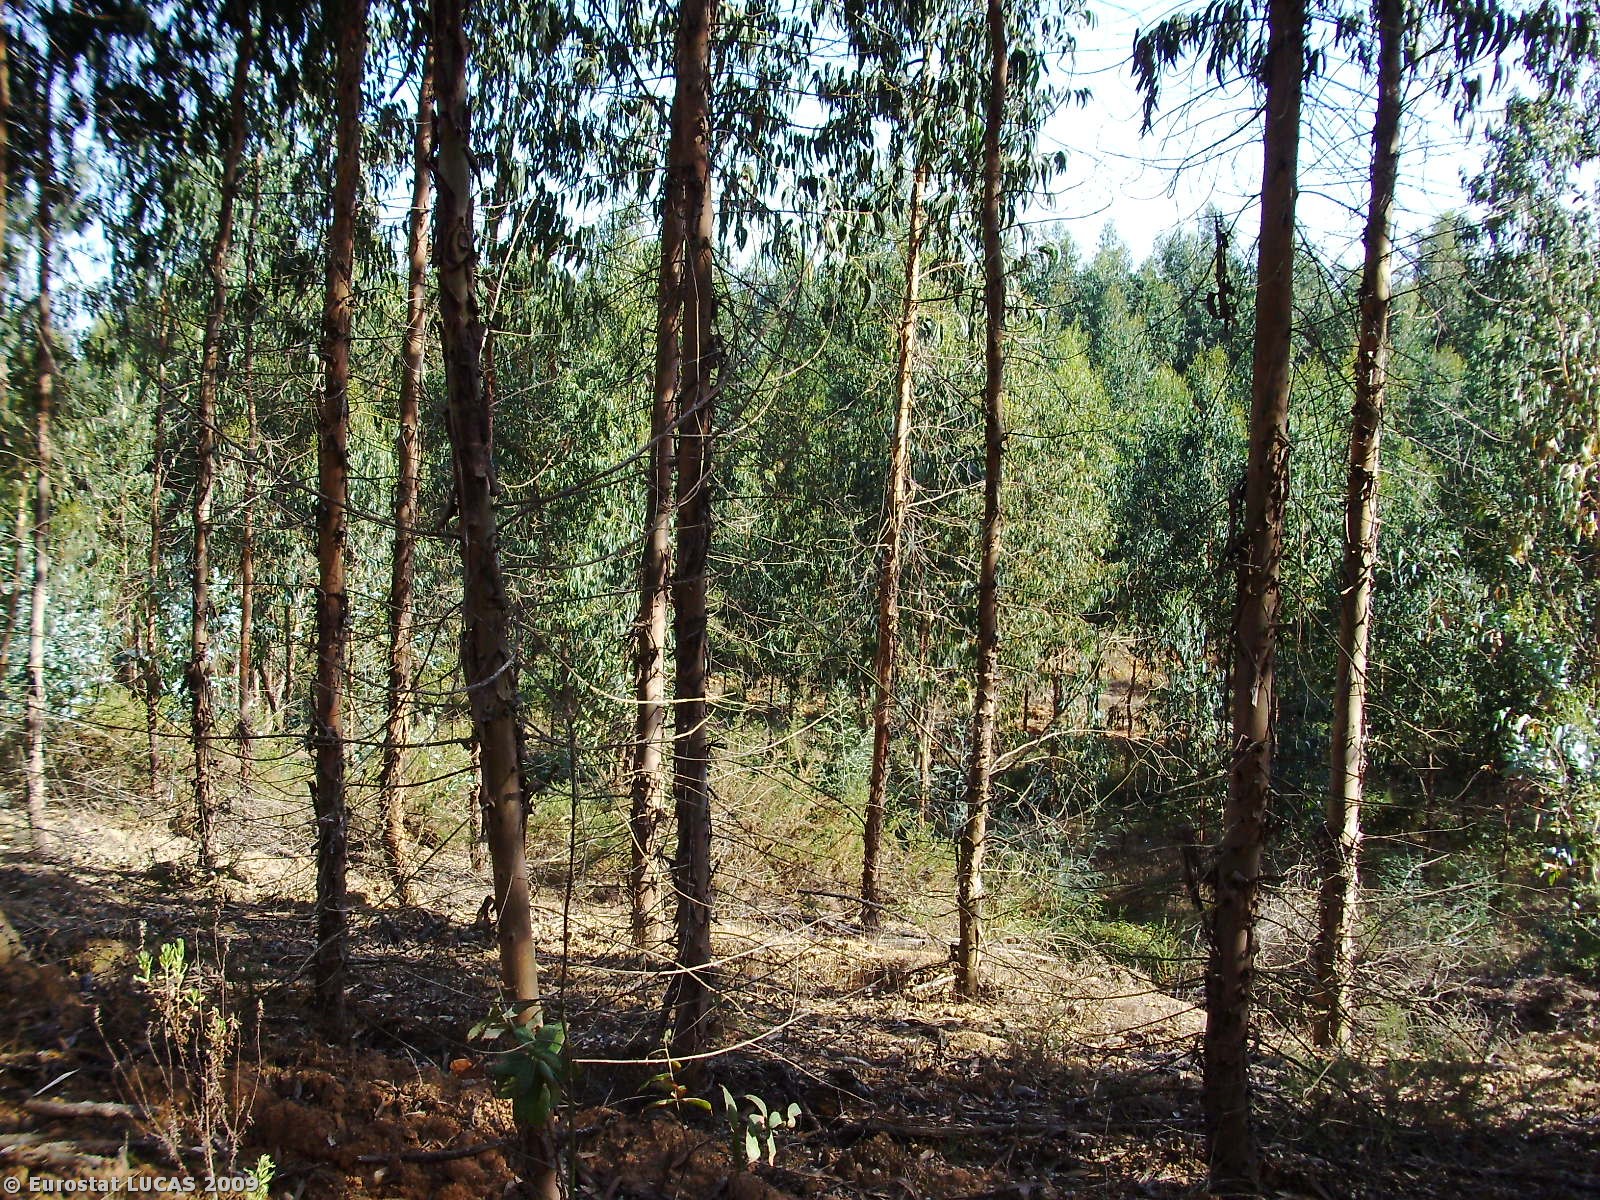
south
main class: Woodland
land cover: Broadleaved woodland
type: plantations and self-sown exotic forest
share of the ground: > 75 %
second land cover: Bare land
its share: 10 - 25 %
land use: Forestry
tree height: > 5 m
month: July
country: PT
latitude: 39.3532
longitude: -8.8201
